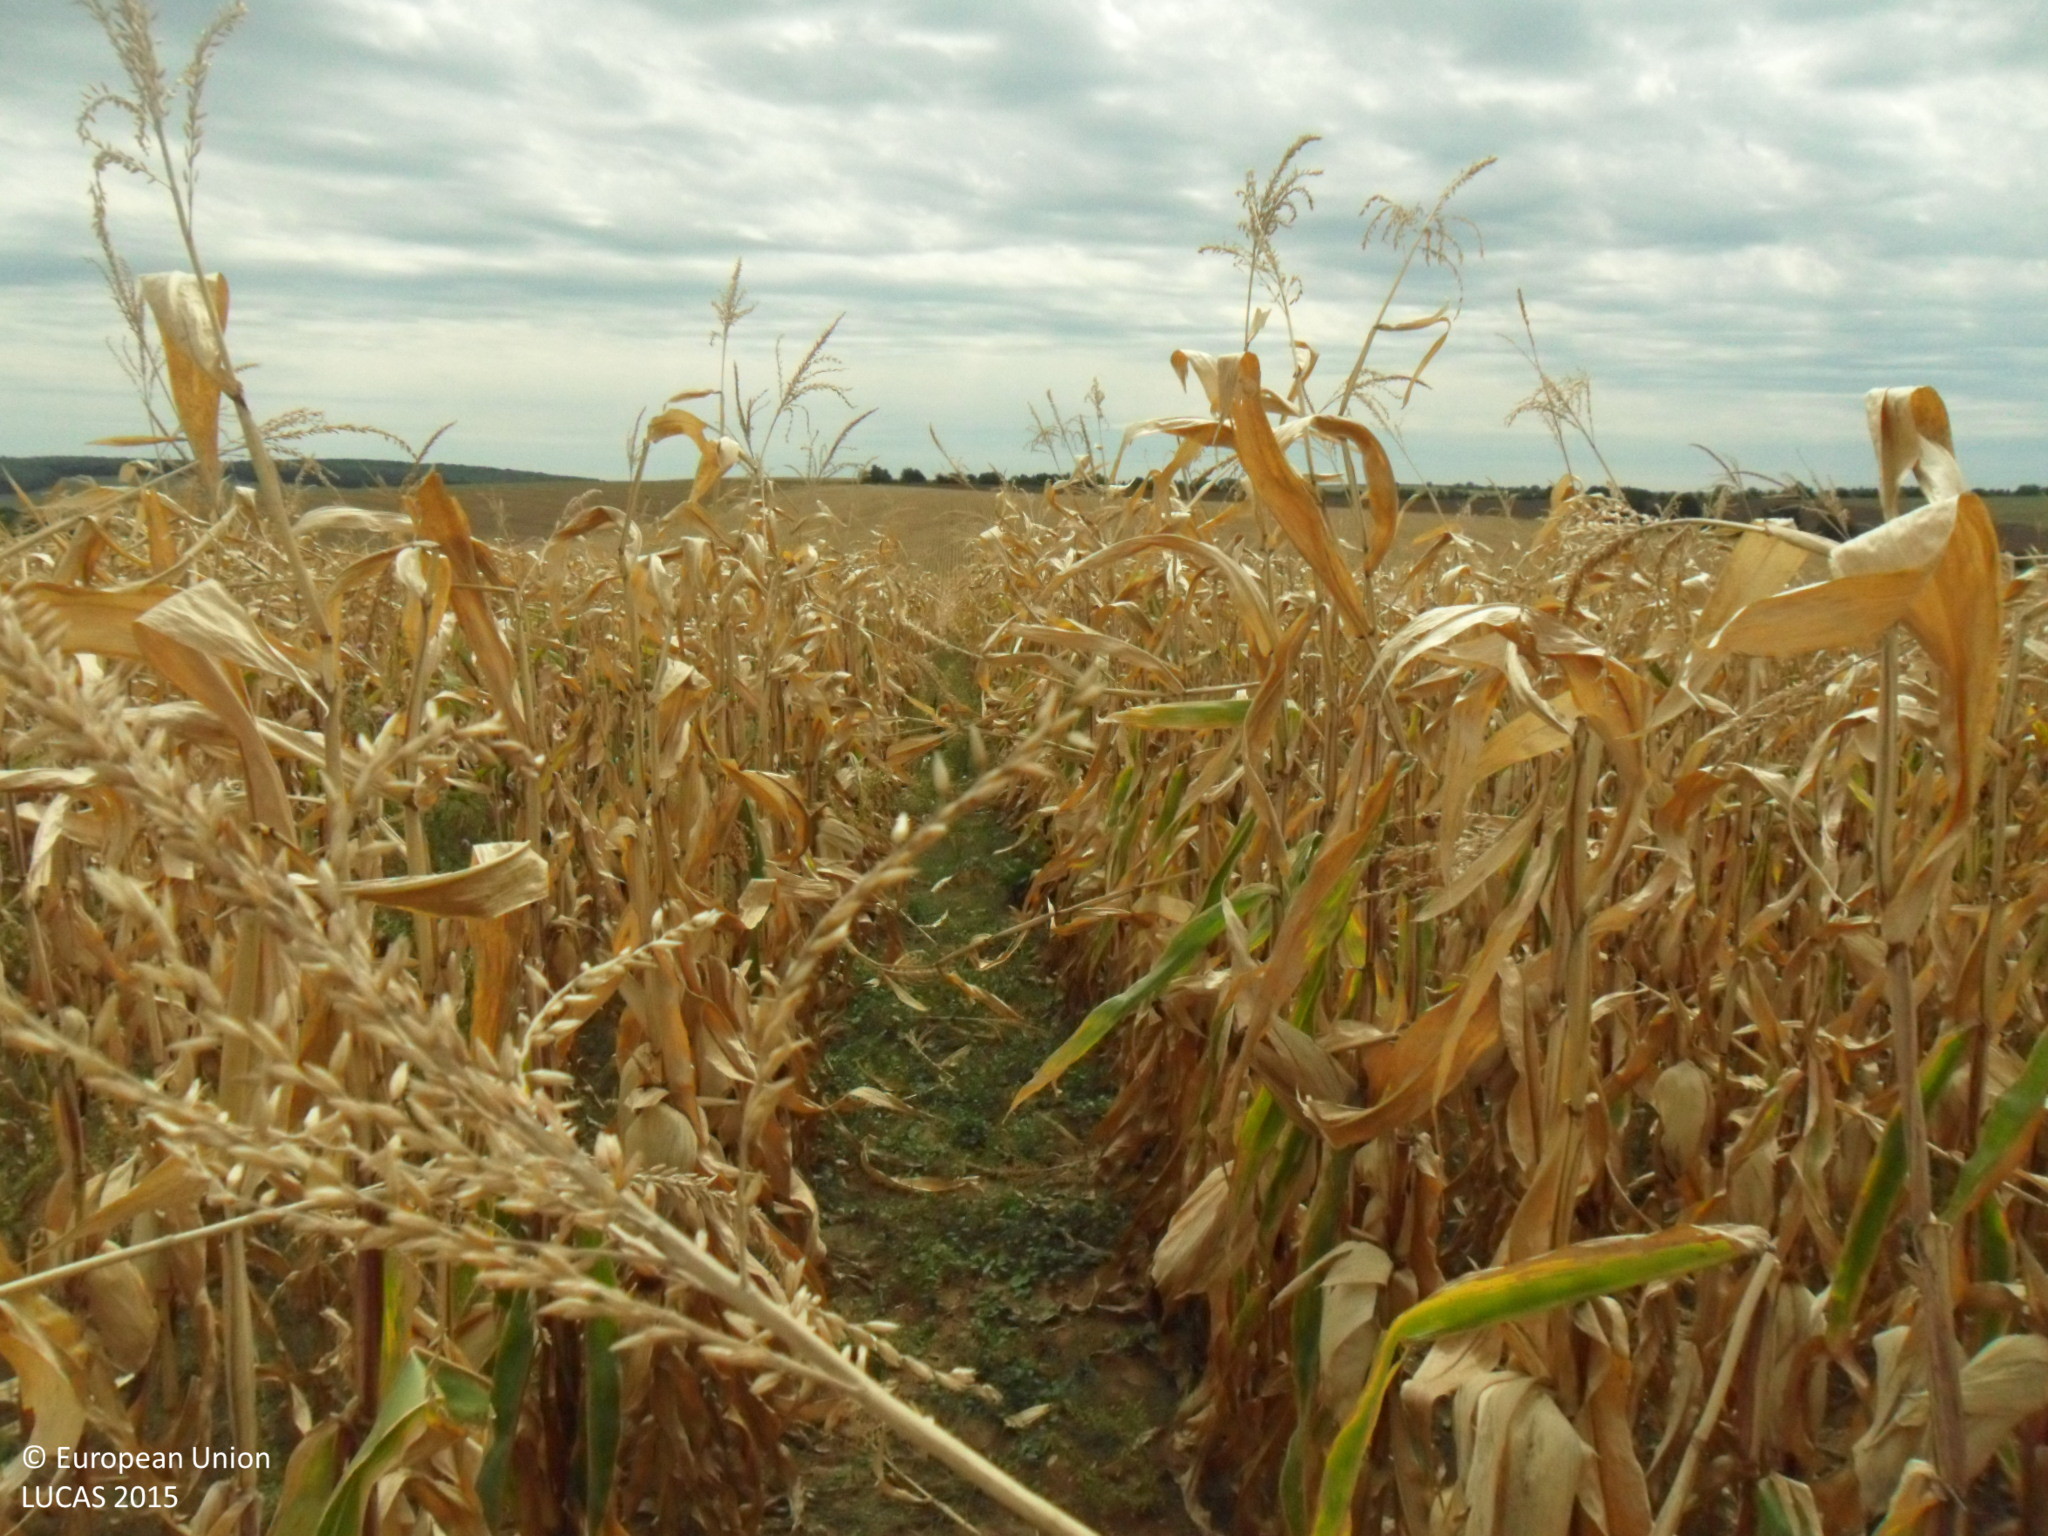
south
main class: Cropland
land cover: Maize
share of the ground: > 75 %
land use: Agriculture (excluding fallow land and kitchen gardens)
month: September
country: BG
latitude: 43.5255
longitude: 26.3211
